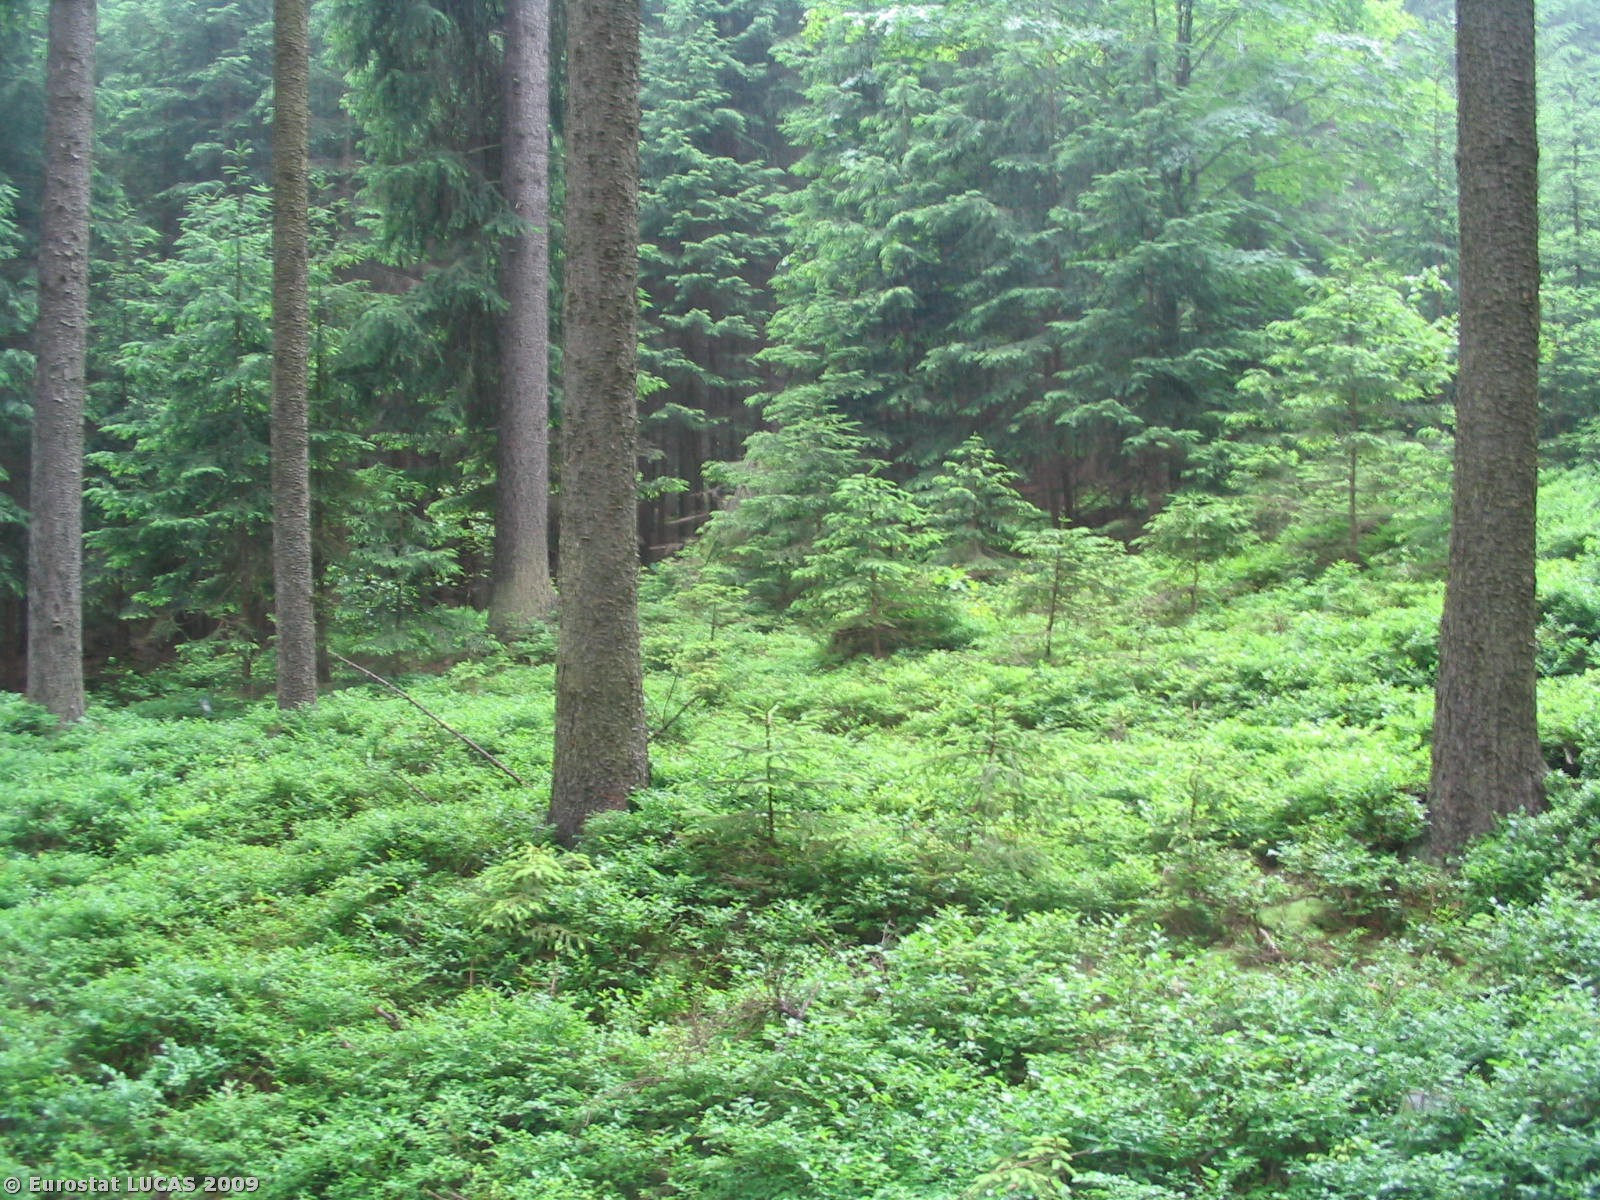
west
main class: Woodland
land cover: Coniferous woodland
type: hemiboreal forest and nemoral coniferous forest and mixed broadleaved-coniferous forest
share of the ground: > 75 %
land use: Forestry
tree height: > 5 m
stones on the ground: < 10 %
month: June
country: CZ
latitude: 49.5049
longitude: 18.7339
